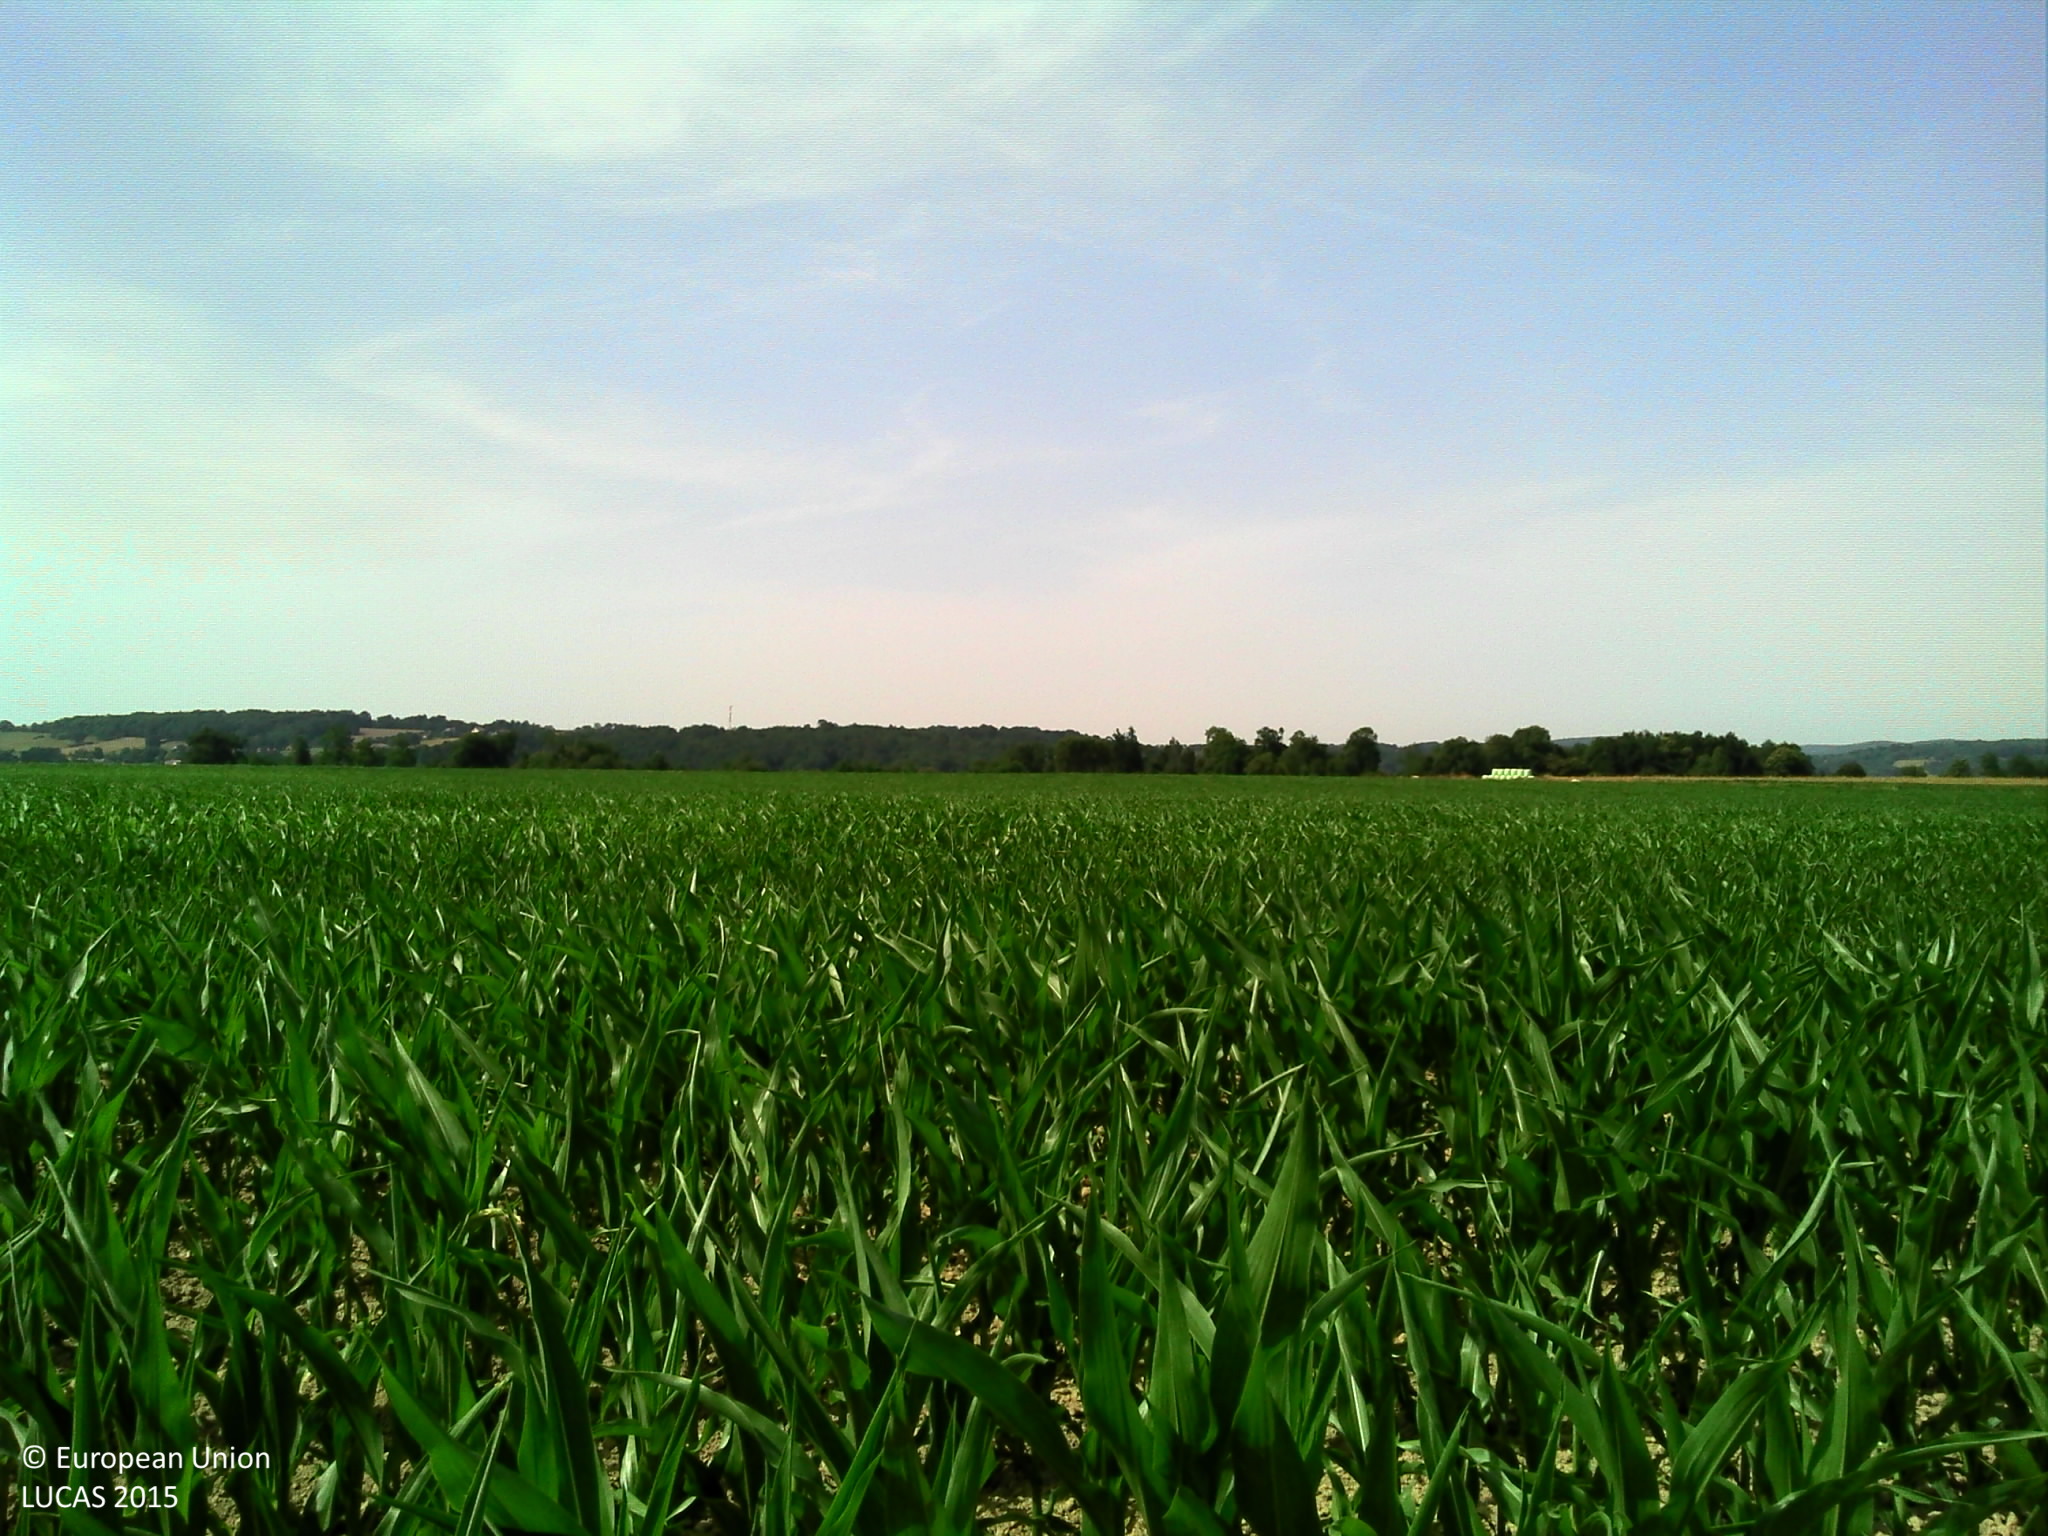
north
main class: Cropland
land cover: Maize
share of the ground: 50 - 75 %
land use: Agriculture (excluding fallow land and kitchen gardens)
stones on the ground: < 10 %
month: July
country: FR
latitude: 43.0948
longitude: 0.8745
